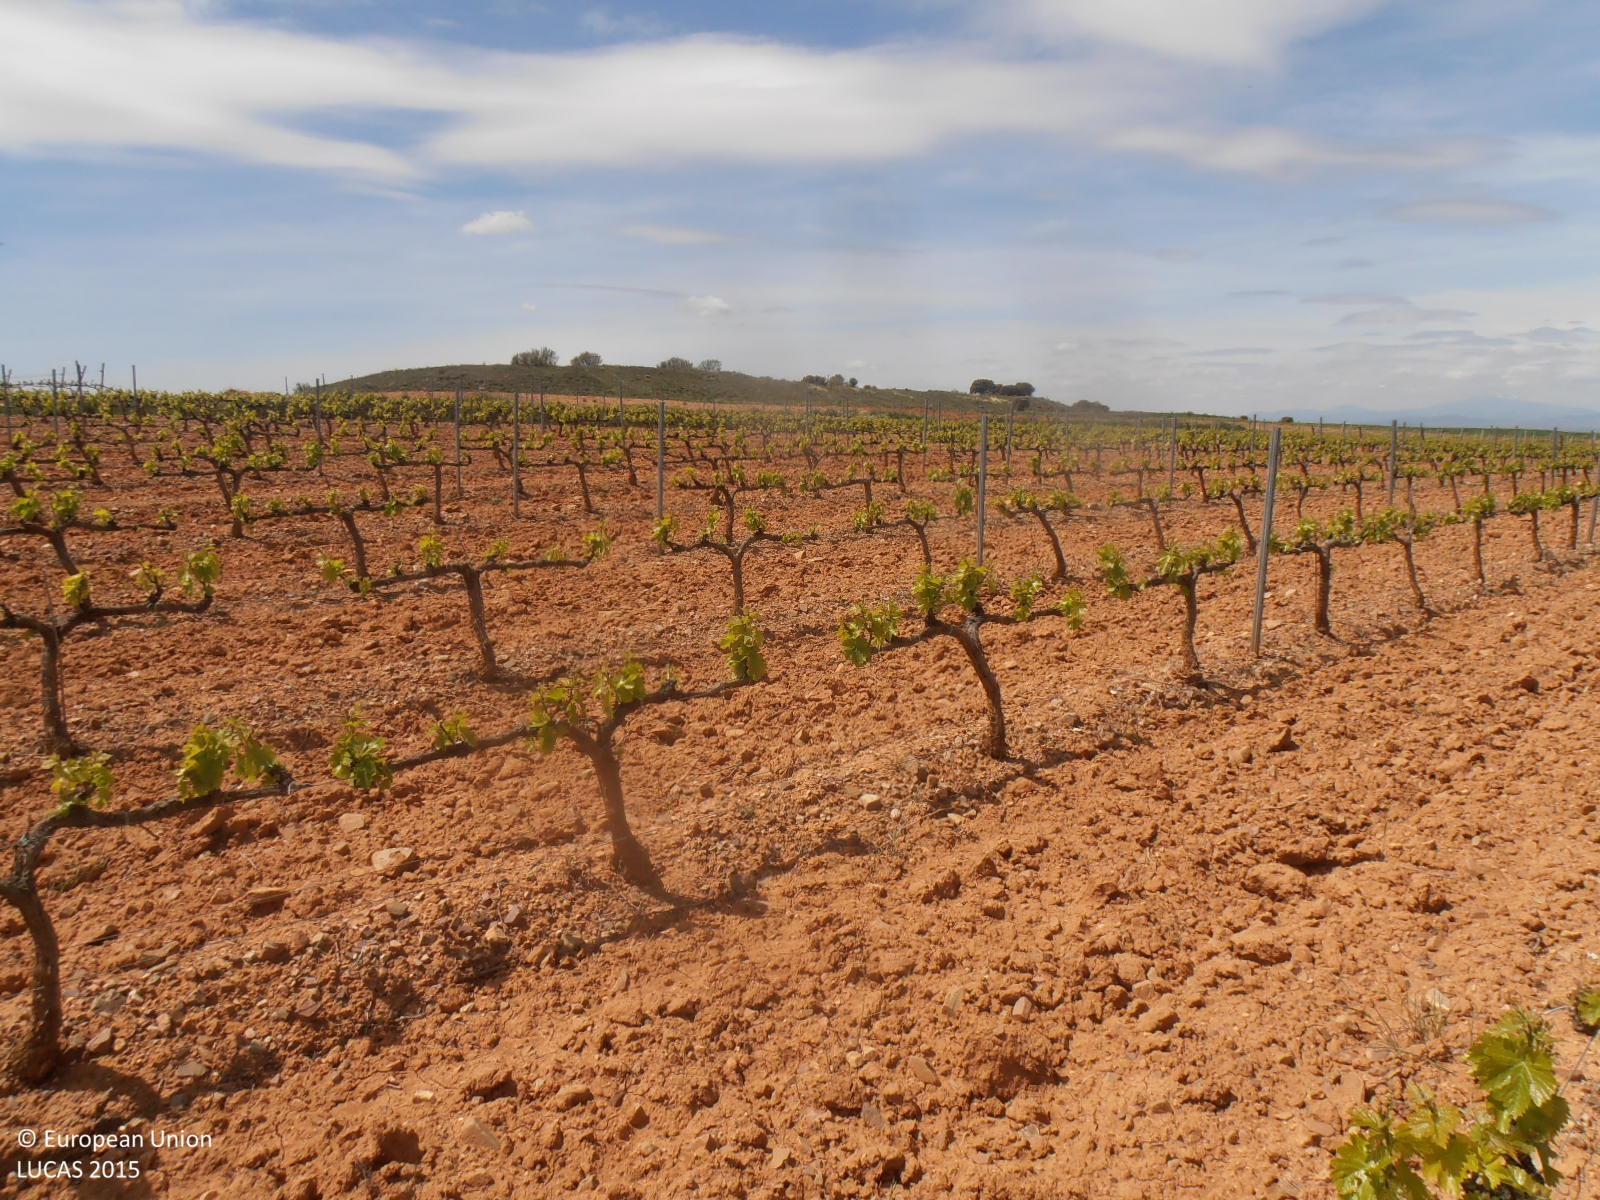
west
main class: Cropland
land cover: Vineyards
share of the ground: < 10 %
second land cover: Other bare soil
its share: > 75 %
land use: Agriculture (excluding fallow land and kitchen gardens)
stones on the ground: < 10 %
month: April
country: ES
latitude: 41.3622
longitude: -1.1505
